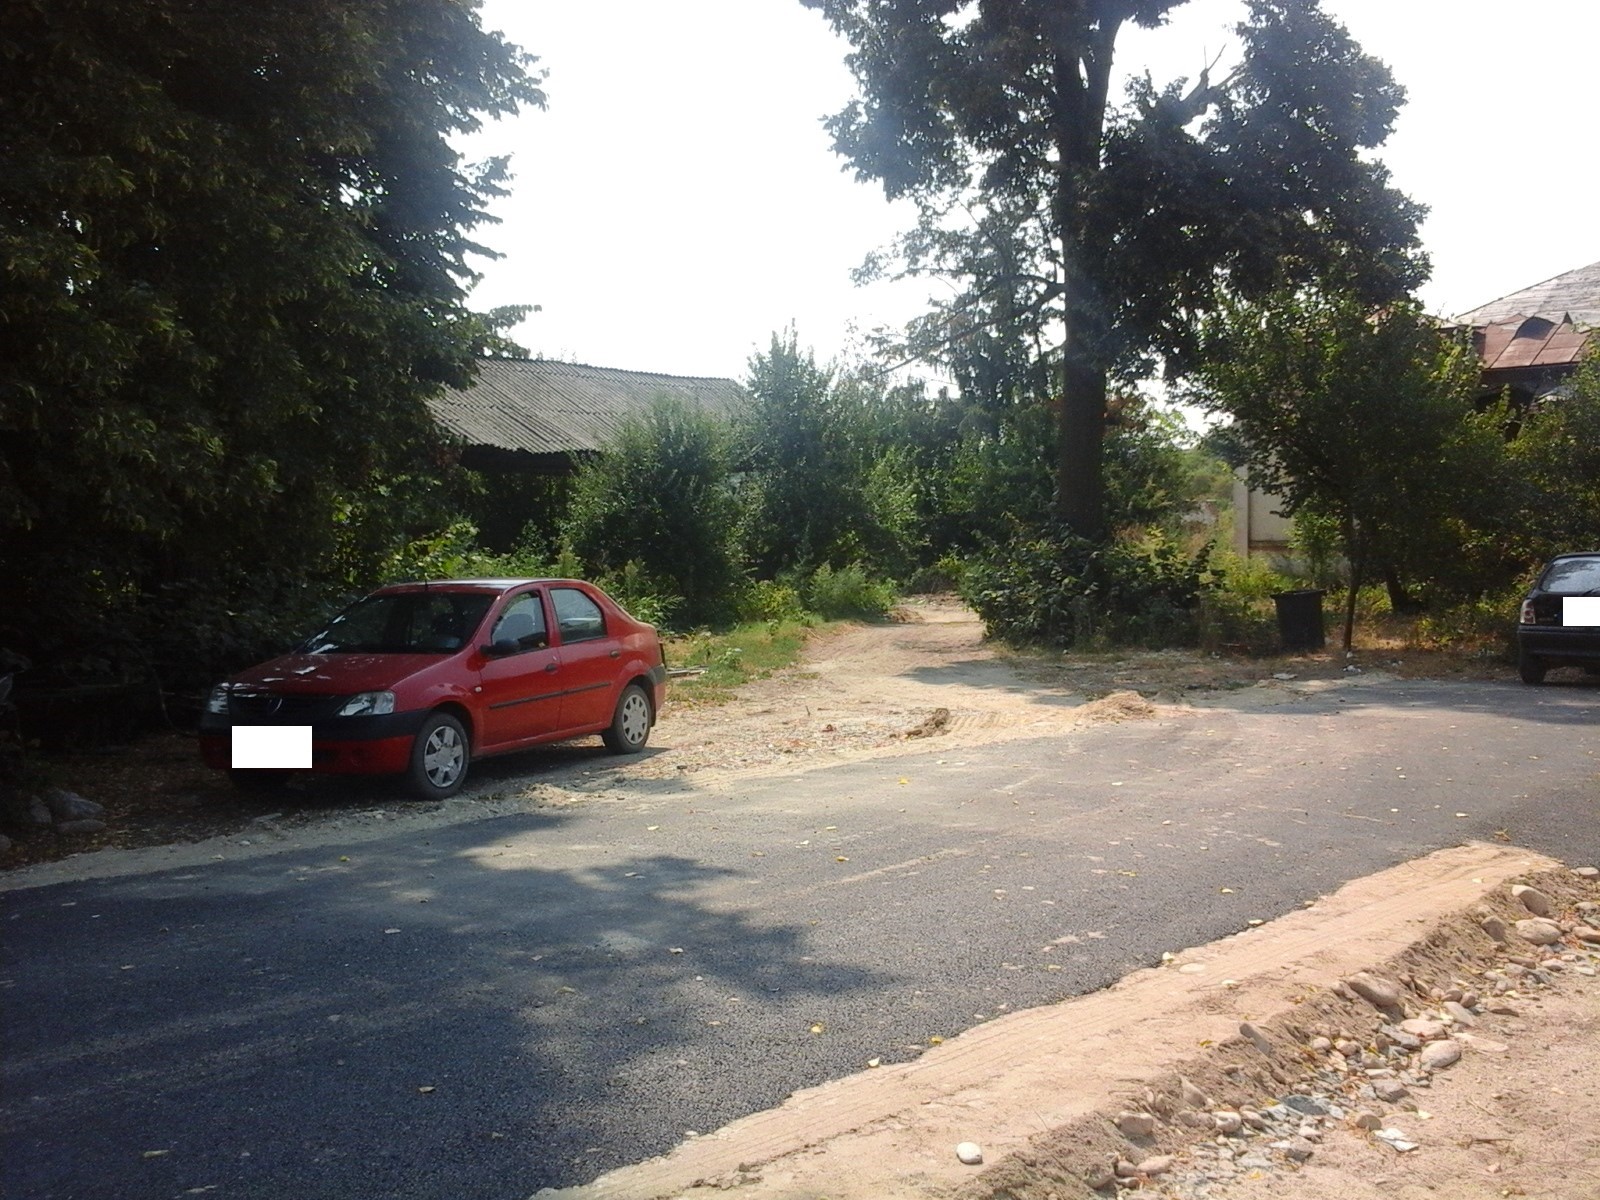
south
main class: Cropland
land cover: Other fresh vegetables
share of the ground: > 75 %
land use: Kitchen garden
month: August
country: RO
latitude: 44.5495
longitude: 23.7149
